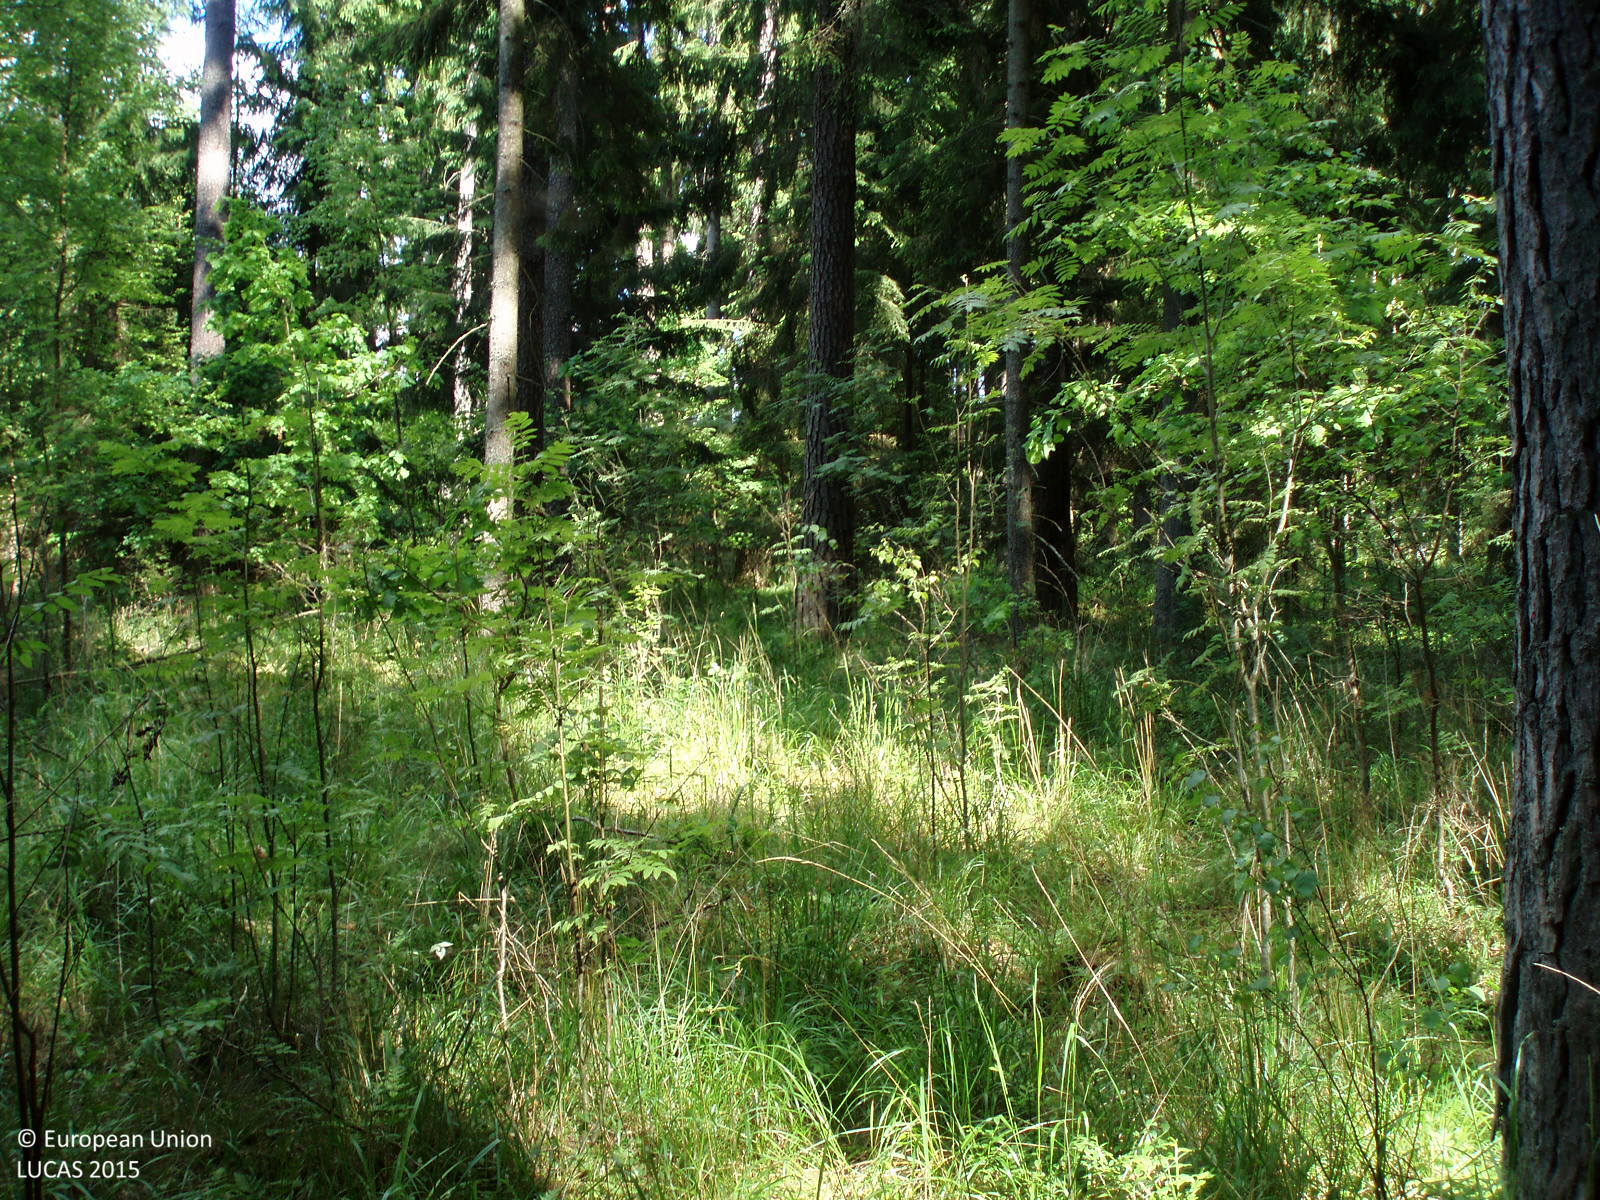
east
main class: Woodland
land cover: Other coniferous woodland
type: hemiboreal forest and nemoral coniferous forest and mixed broadleaved-coniferous forest
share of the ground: > 75 %
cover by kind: coniferous forest trees 70 %, herbaceous plants 20 %, broadleaved forest trees 10 %
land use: Forestry
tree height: > 5 m
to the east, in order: Other coniferous woodland; Paved roads, cycling and walking lanes; Other coniferous woodland; Pine dominated mixed woodland
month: June
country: LT
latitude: 55.0686
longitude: 22.4484
